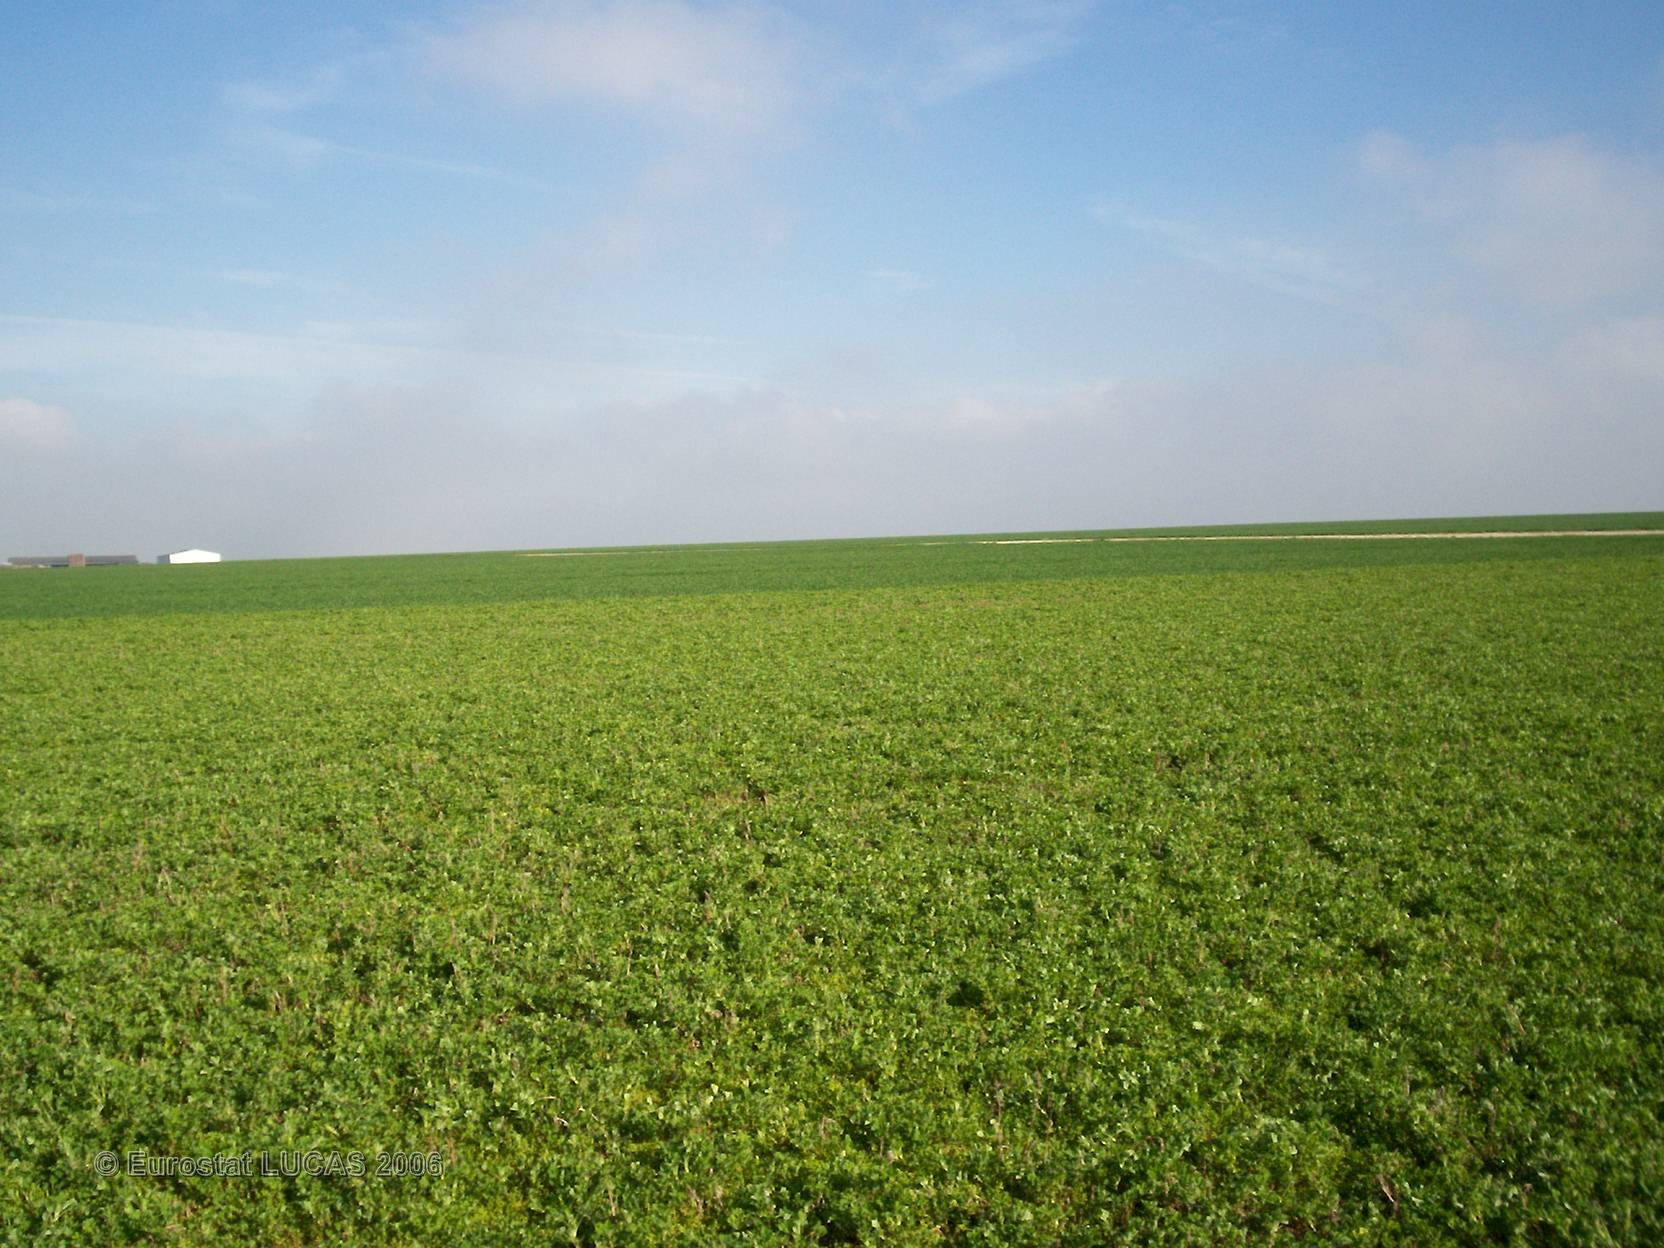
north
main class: Cropland
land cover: Lucerne
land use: Agriculture (excluding fallow land and kitchen gardens)
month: April
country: FR
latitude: 49.0896
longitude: 4.3682
